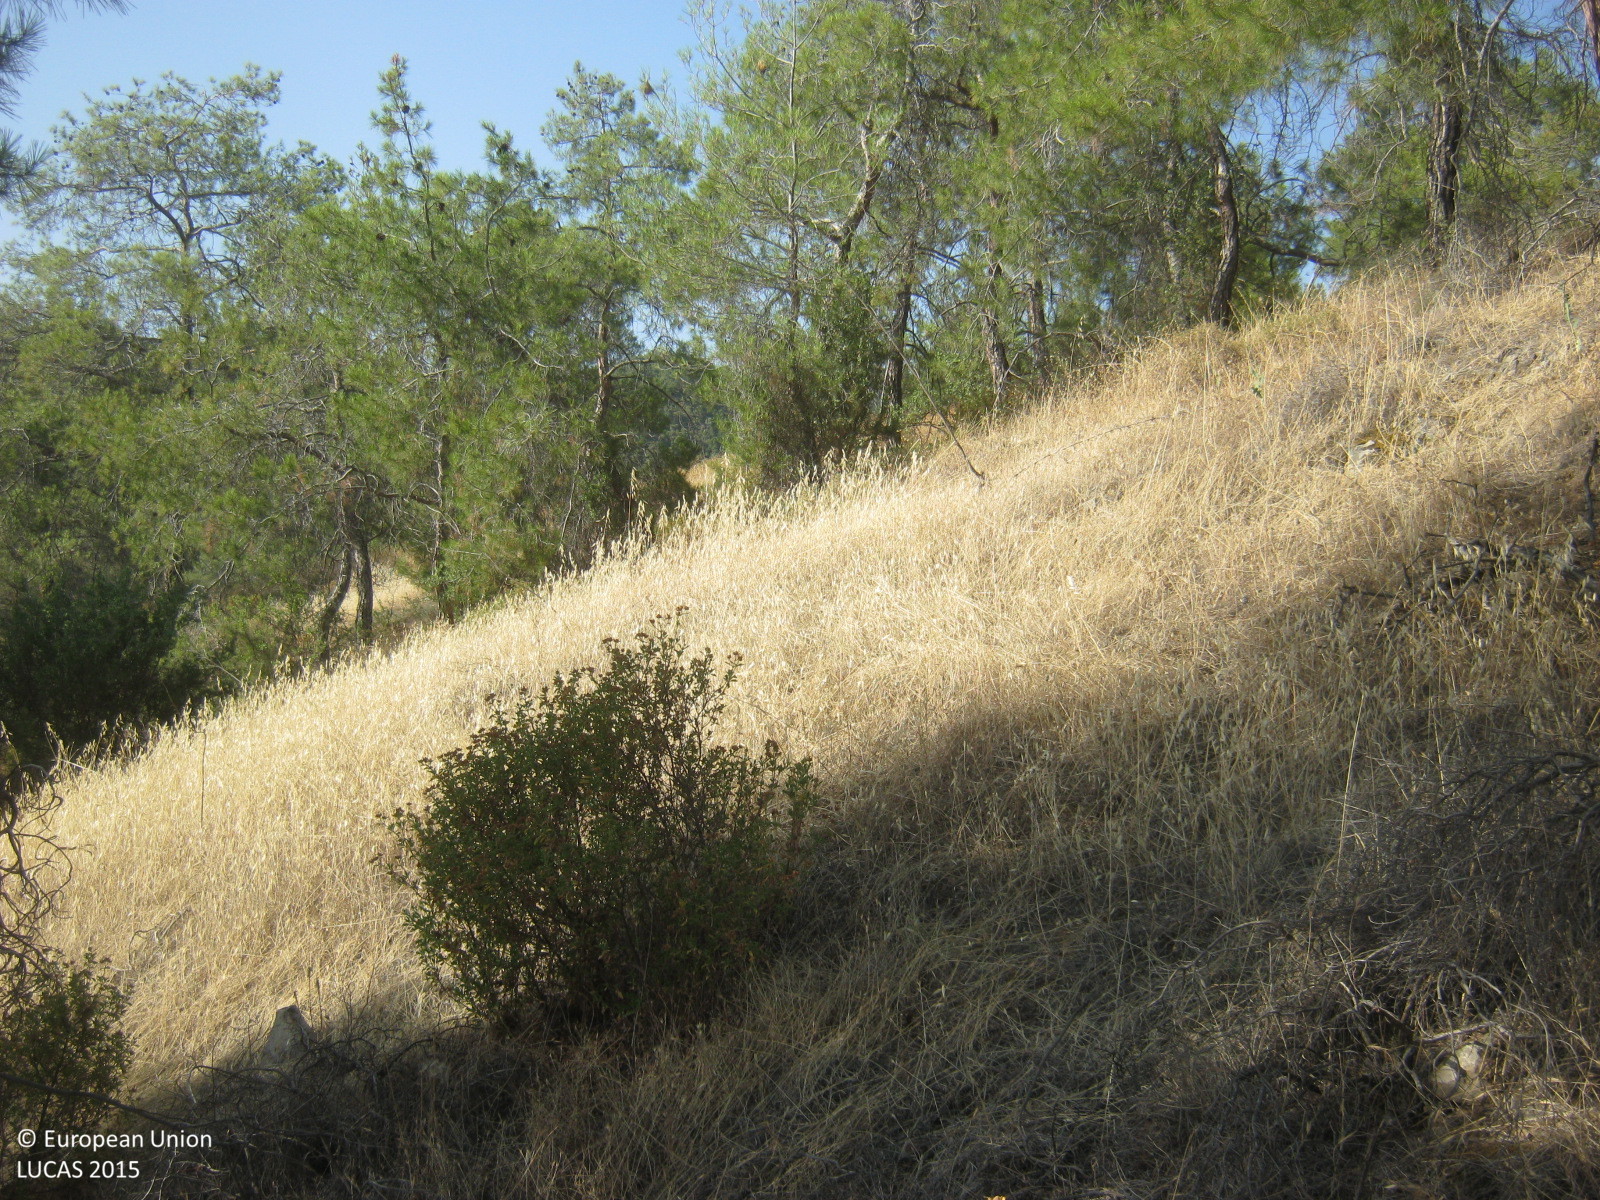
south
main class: Woodland
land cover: Pine dominated coniferous woodland
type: coniferous forest of the mediterranean region
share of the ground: > 75 %
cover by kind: coniferous forest trees 75 %, herbaceous plants 15 %, shrubs 10 %
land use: Forestry
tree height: > 5 m
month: June
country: CY
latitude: 35.0583
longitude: 32.9928
